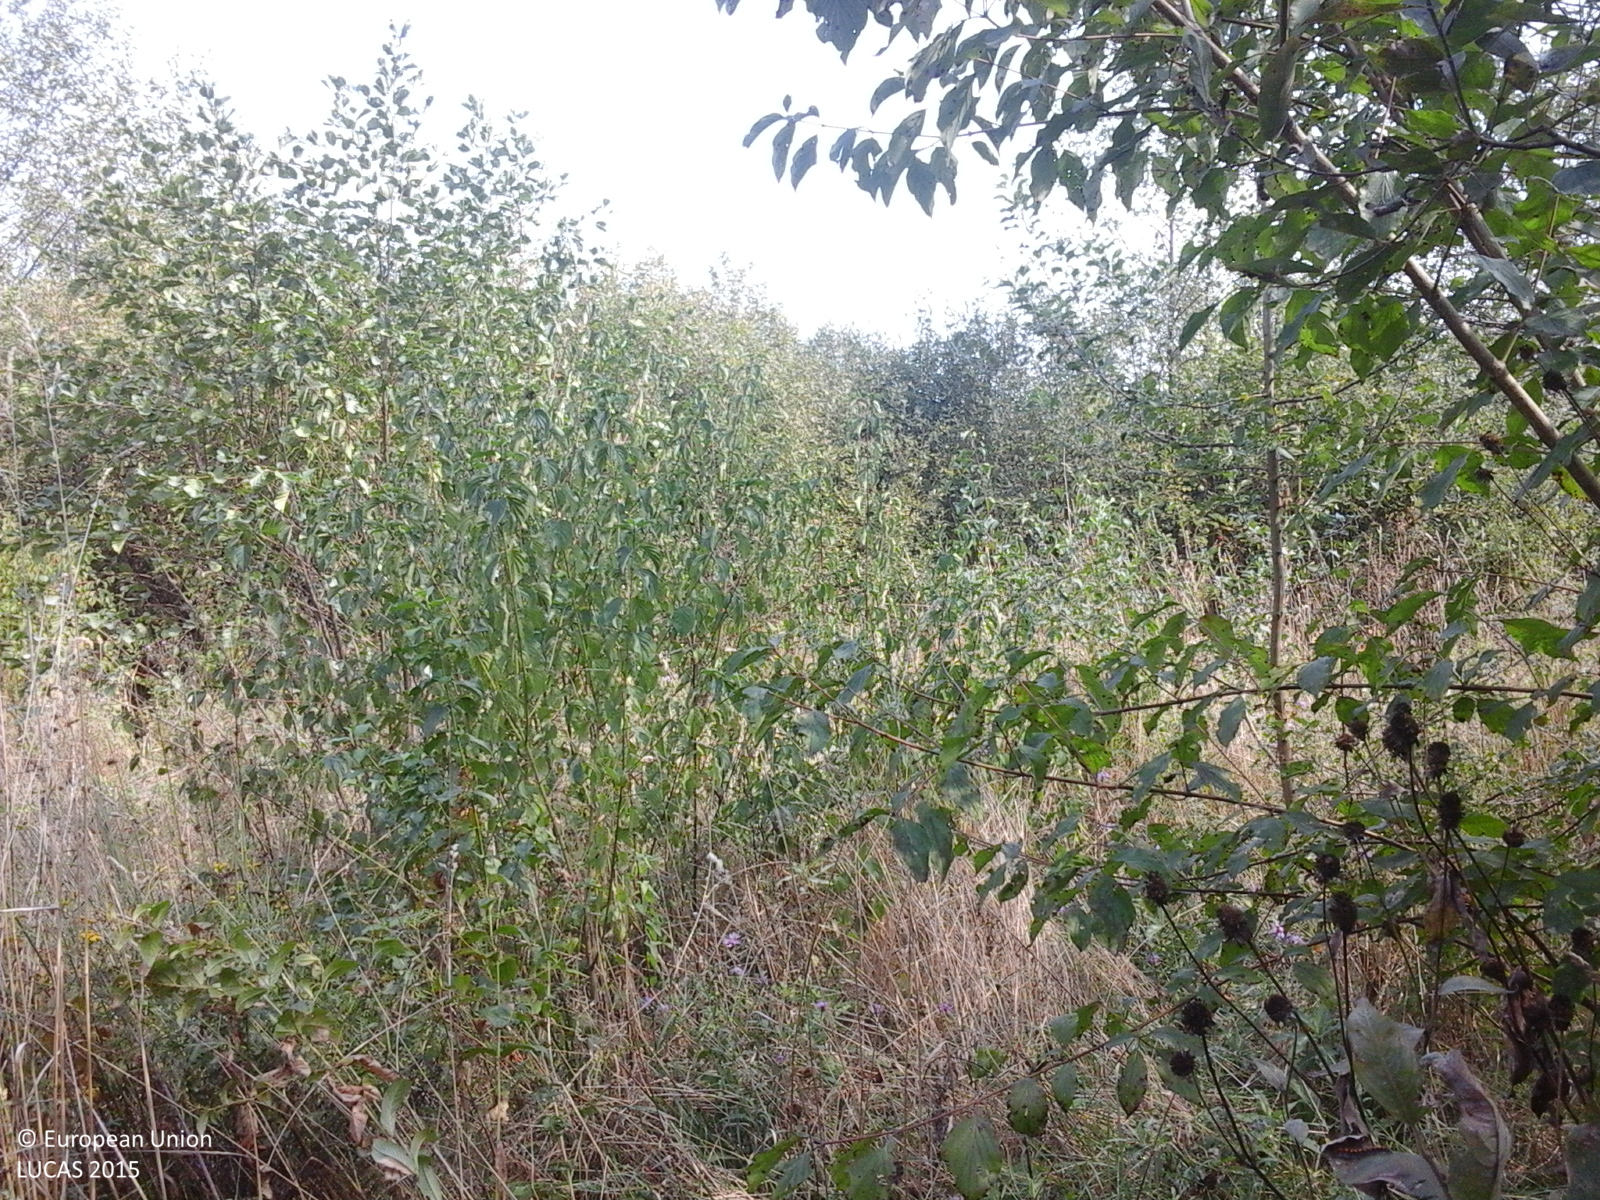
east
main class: Woodland
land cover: Broadleaved woodland
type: non-riverine alder, birch or aspen forest
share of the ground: > 75 %
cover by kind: broadleaved forest trees 100 %
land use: Semi-natural and natural areas not in use
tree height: < 5 m
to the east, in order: Broadleaved woodland; Tracks; Grassland without tree/shrub cover; Broadleaved woodland; Grassland with sparse tree/shrub cover; Broadleaved woodland; Spontaneously vegetated surfaces; Broadleaved woodland; Tracks; Abandoned hedges; Ditches and canals; Abandoned hedges; Maize; Spontaneously vegetated surfaces; Abandoned hedges; Spontaneously vegetated surfaces
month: September
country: RO
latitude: 45.5086
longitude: 22.1619
